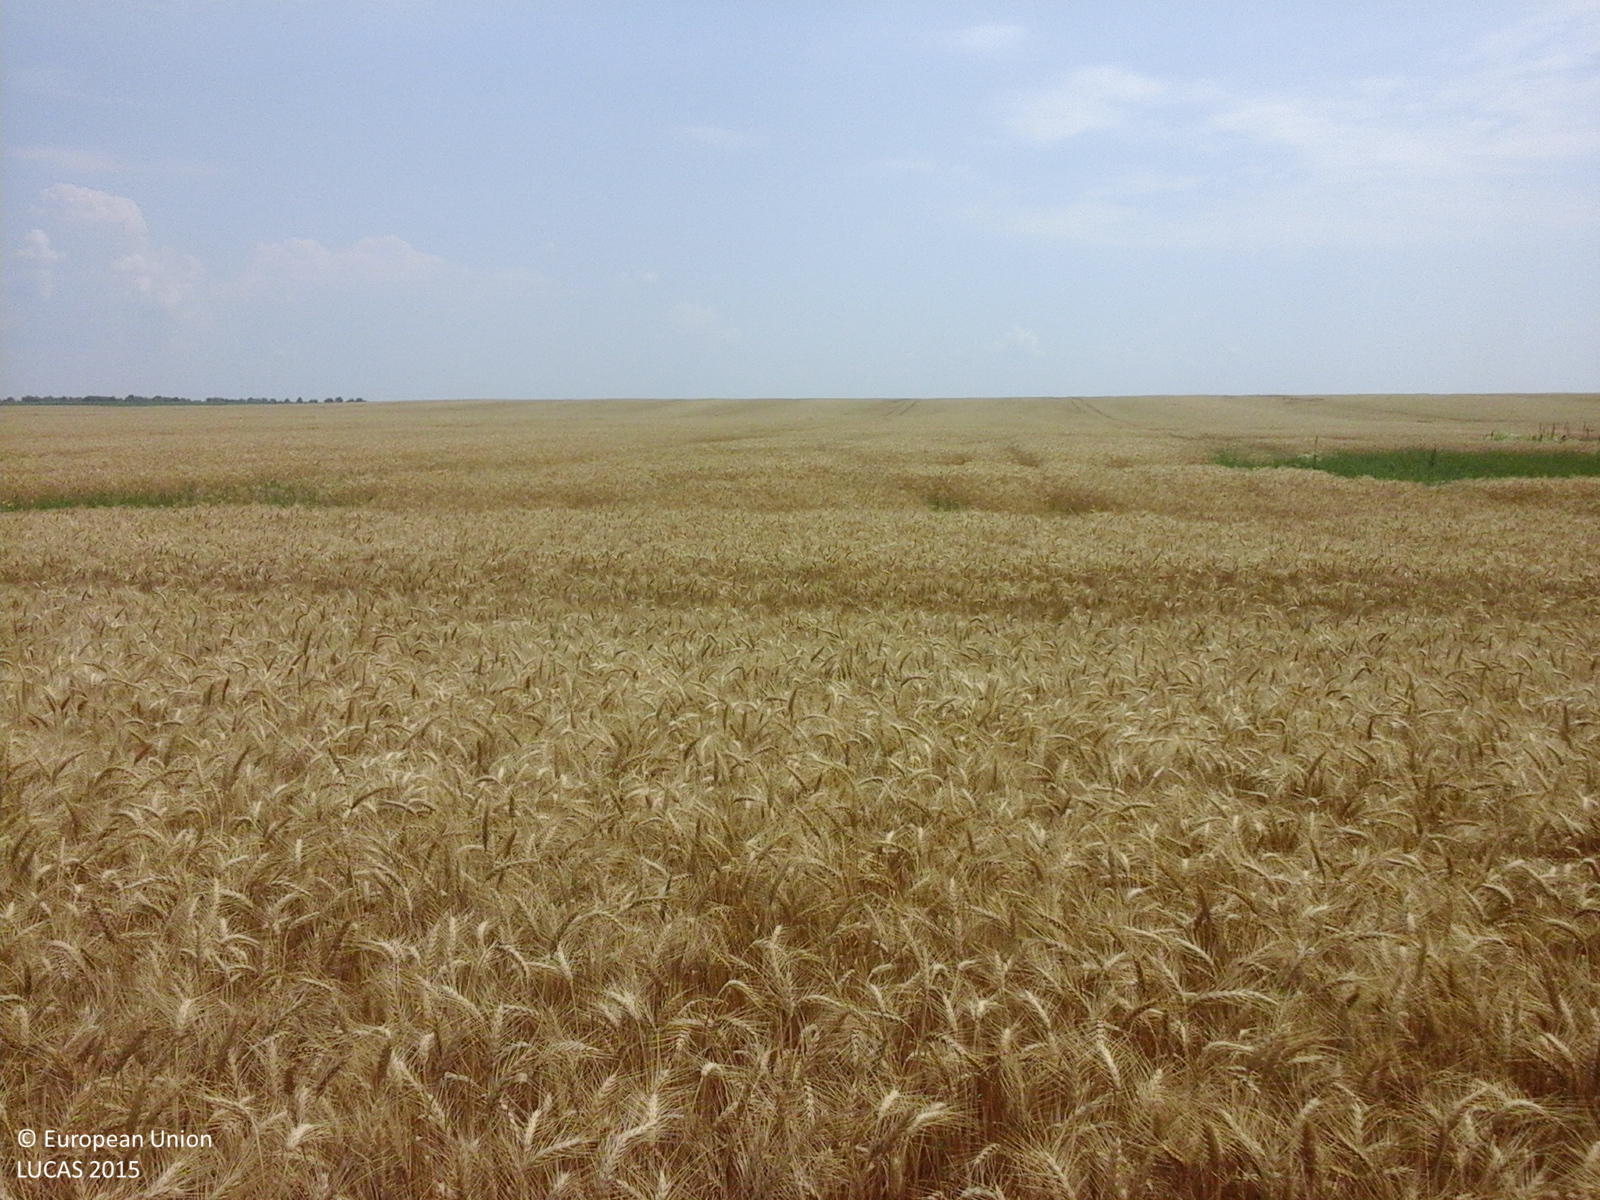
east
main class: Cropland
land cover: Common wheat
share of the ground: > 75 %
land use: Agriculture (excluding fallow land and kitchen gardens)
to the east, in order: Common wheat
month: July
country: RO
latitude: 44.1788
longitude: 26.4855
